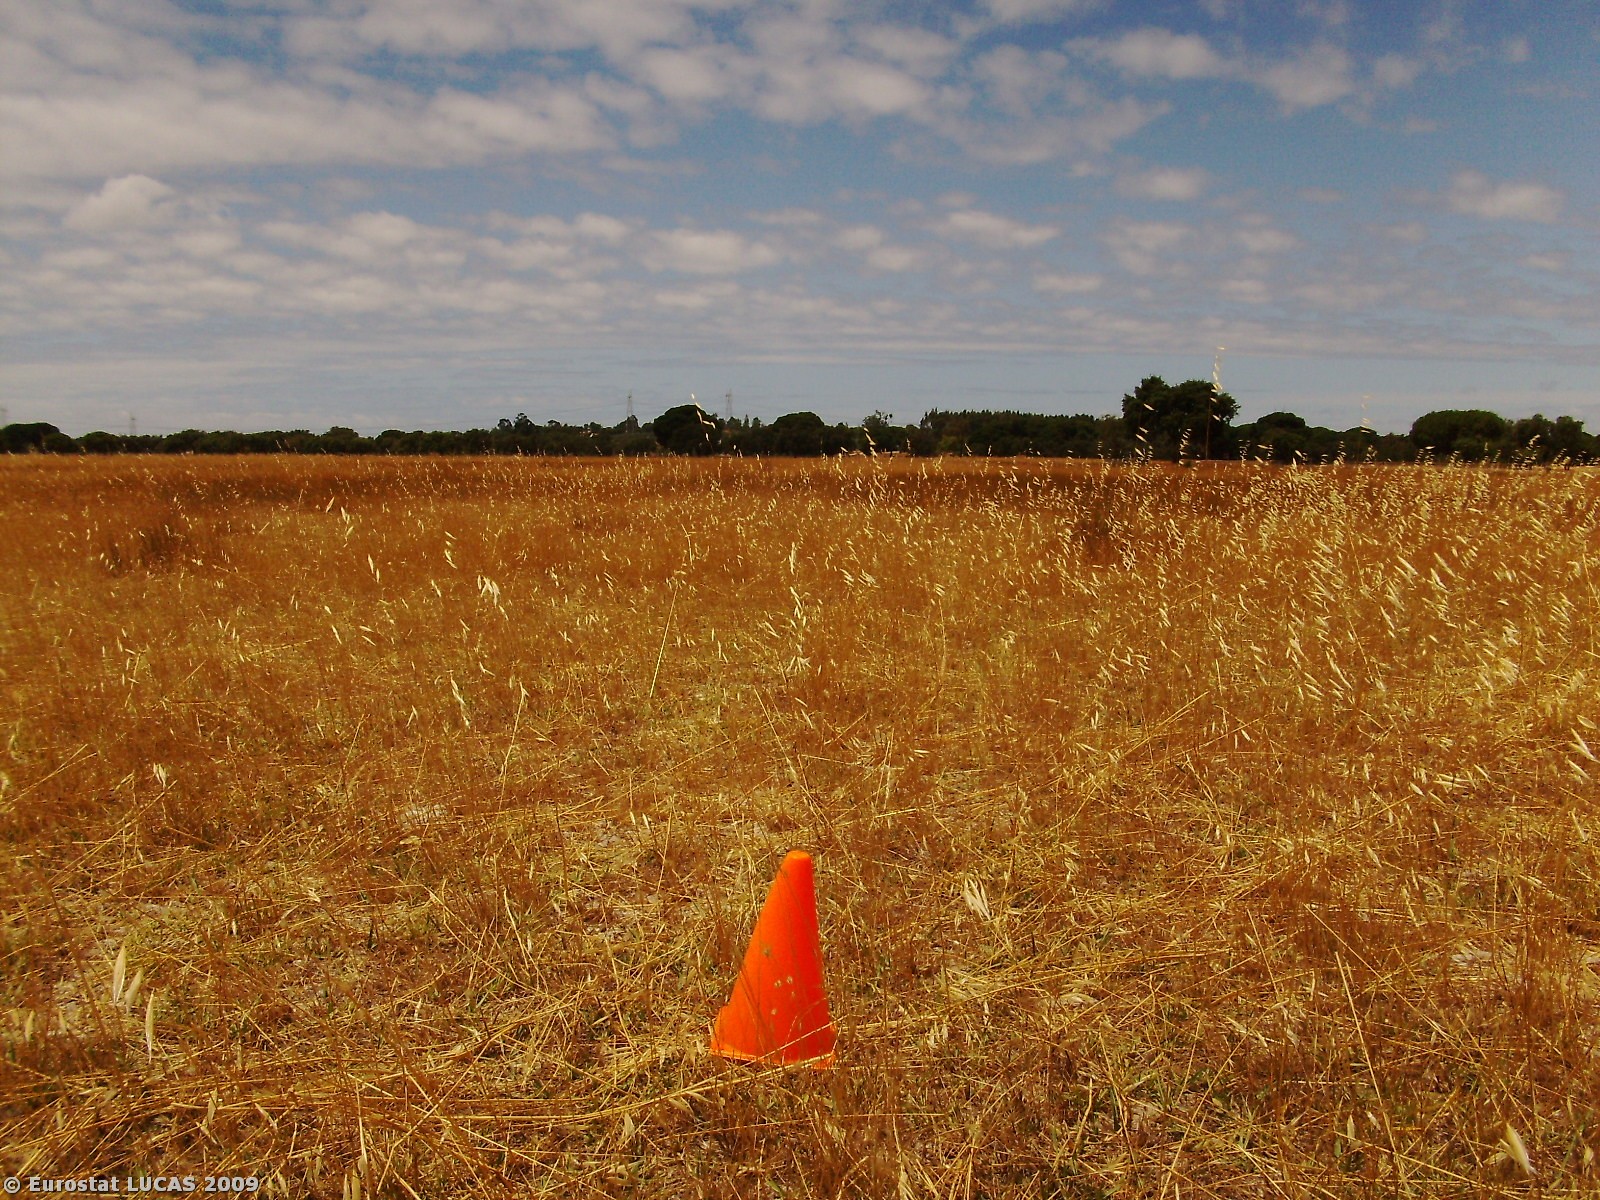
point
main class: Grassland
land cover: Grassland without tree/shrub cover
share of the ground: > 75 %
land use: Agriculture (excluding fallow land and kitchen gardens)
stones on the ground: < 10 %
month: June
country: PT
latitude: 38.1880
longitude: -8.5321
